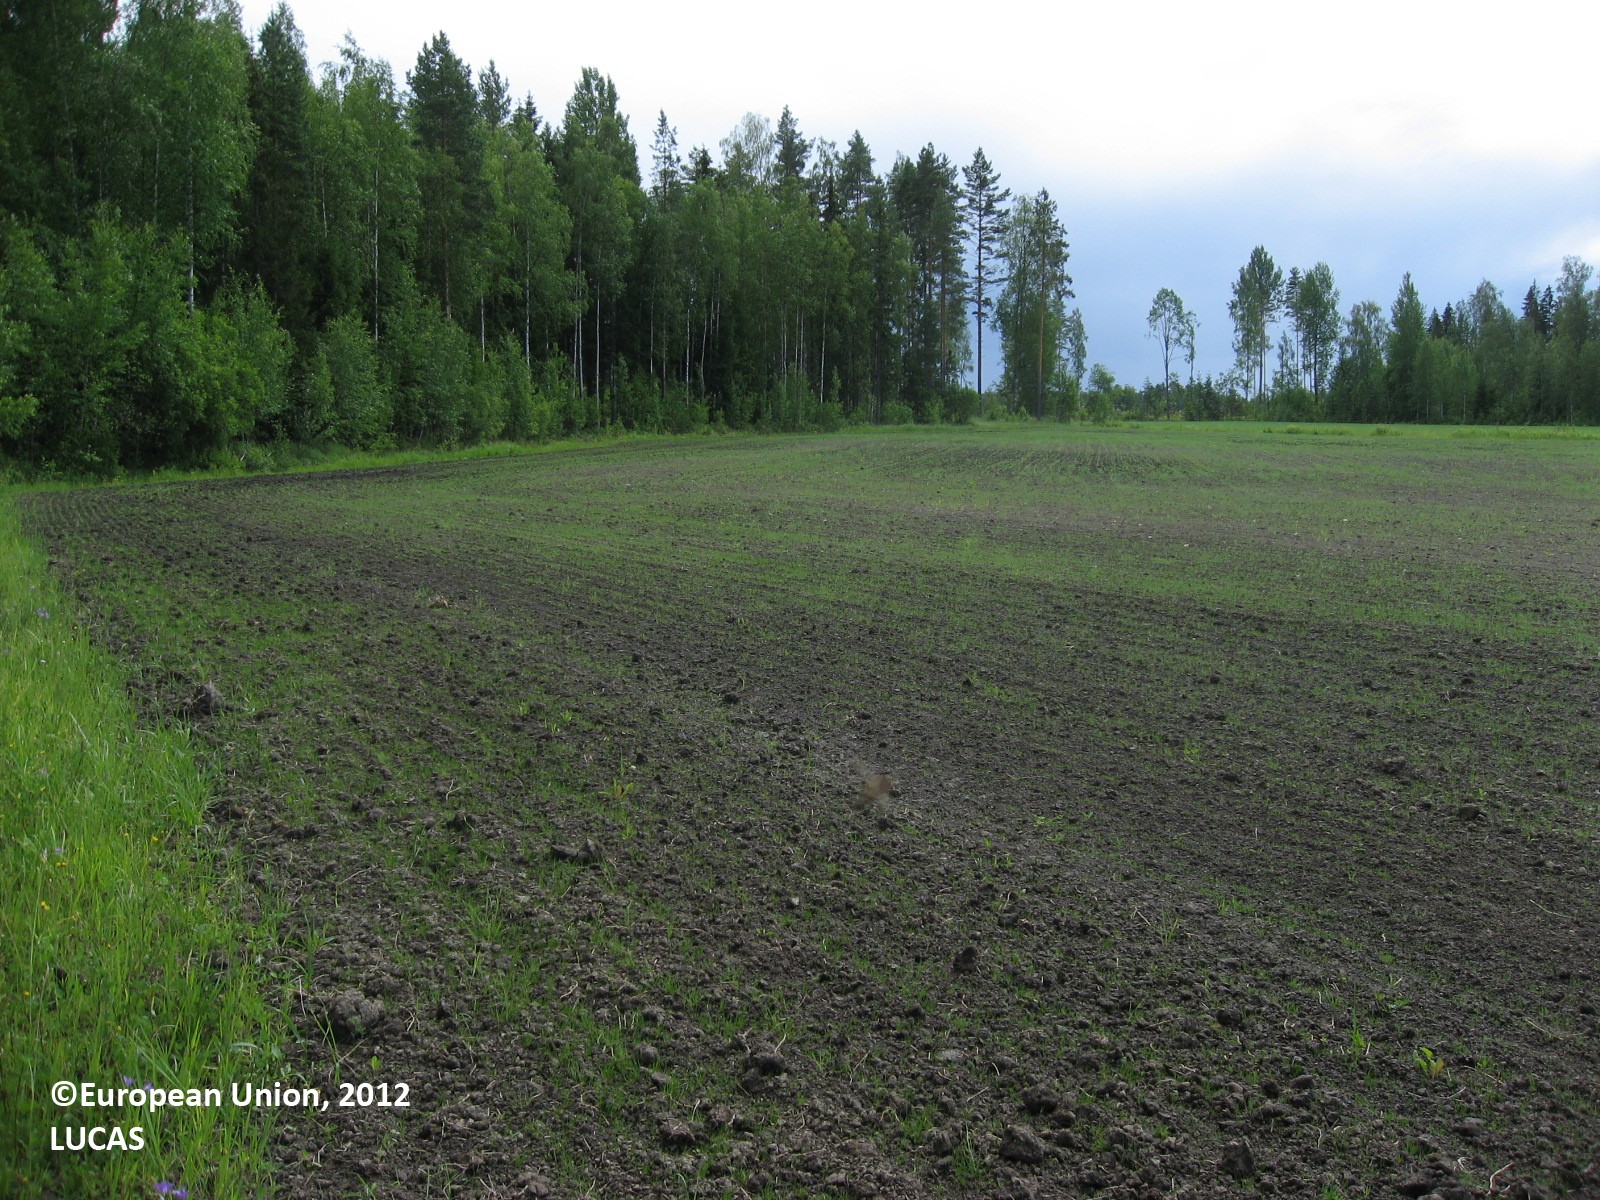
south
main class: Grassland
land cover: Spontaneously vegetated surfaces
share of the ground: < 10 %
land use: Fallow land
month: June
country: FI
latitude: 60.7964
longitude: 26.4116
